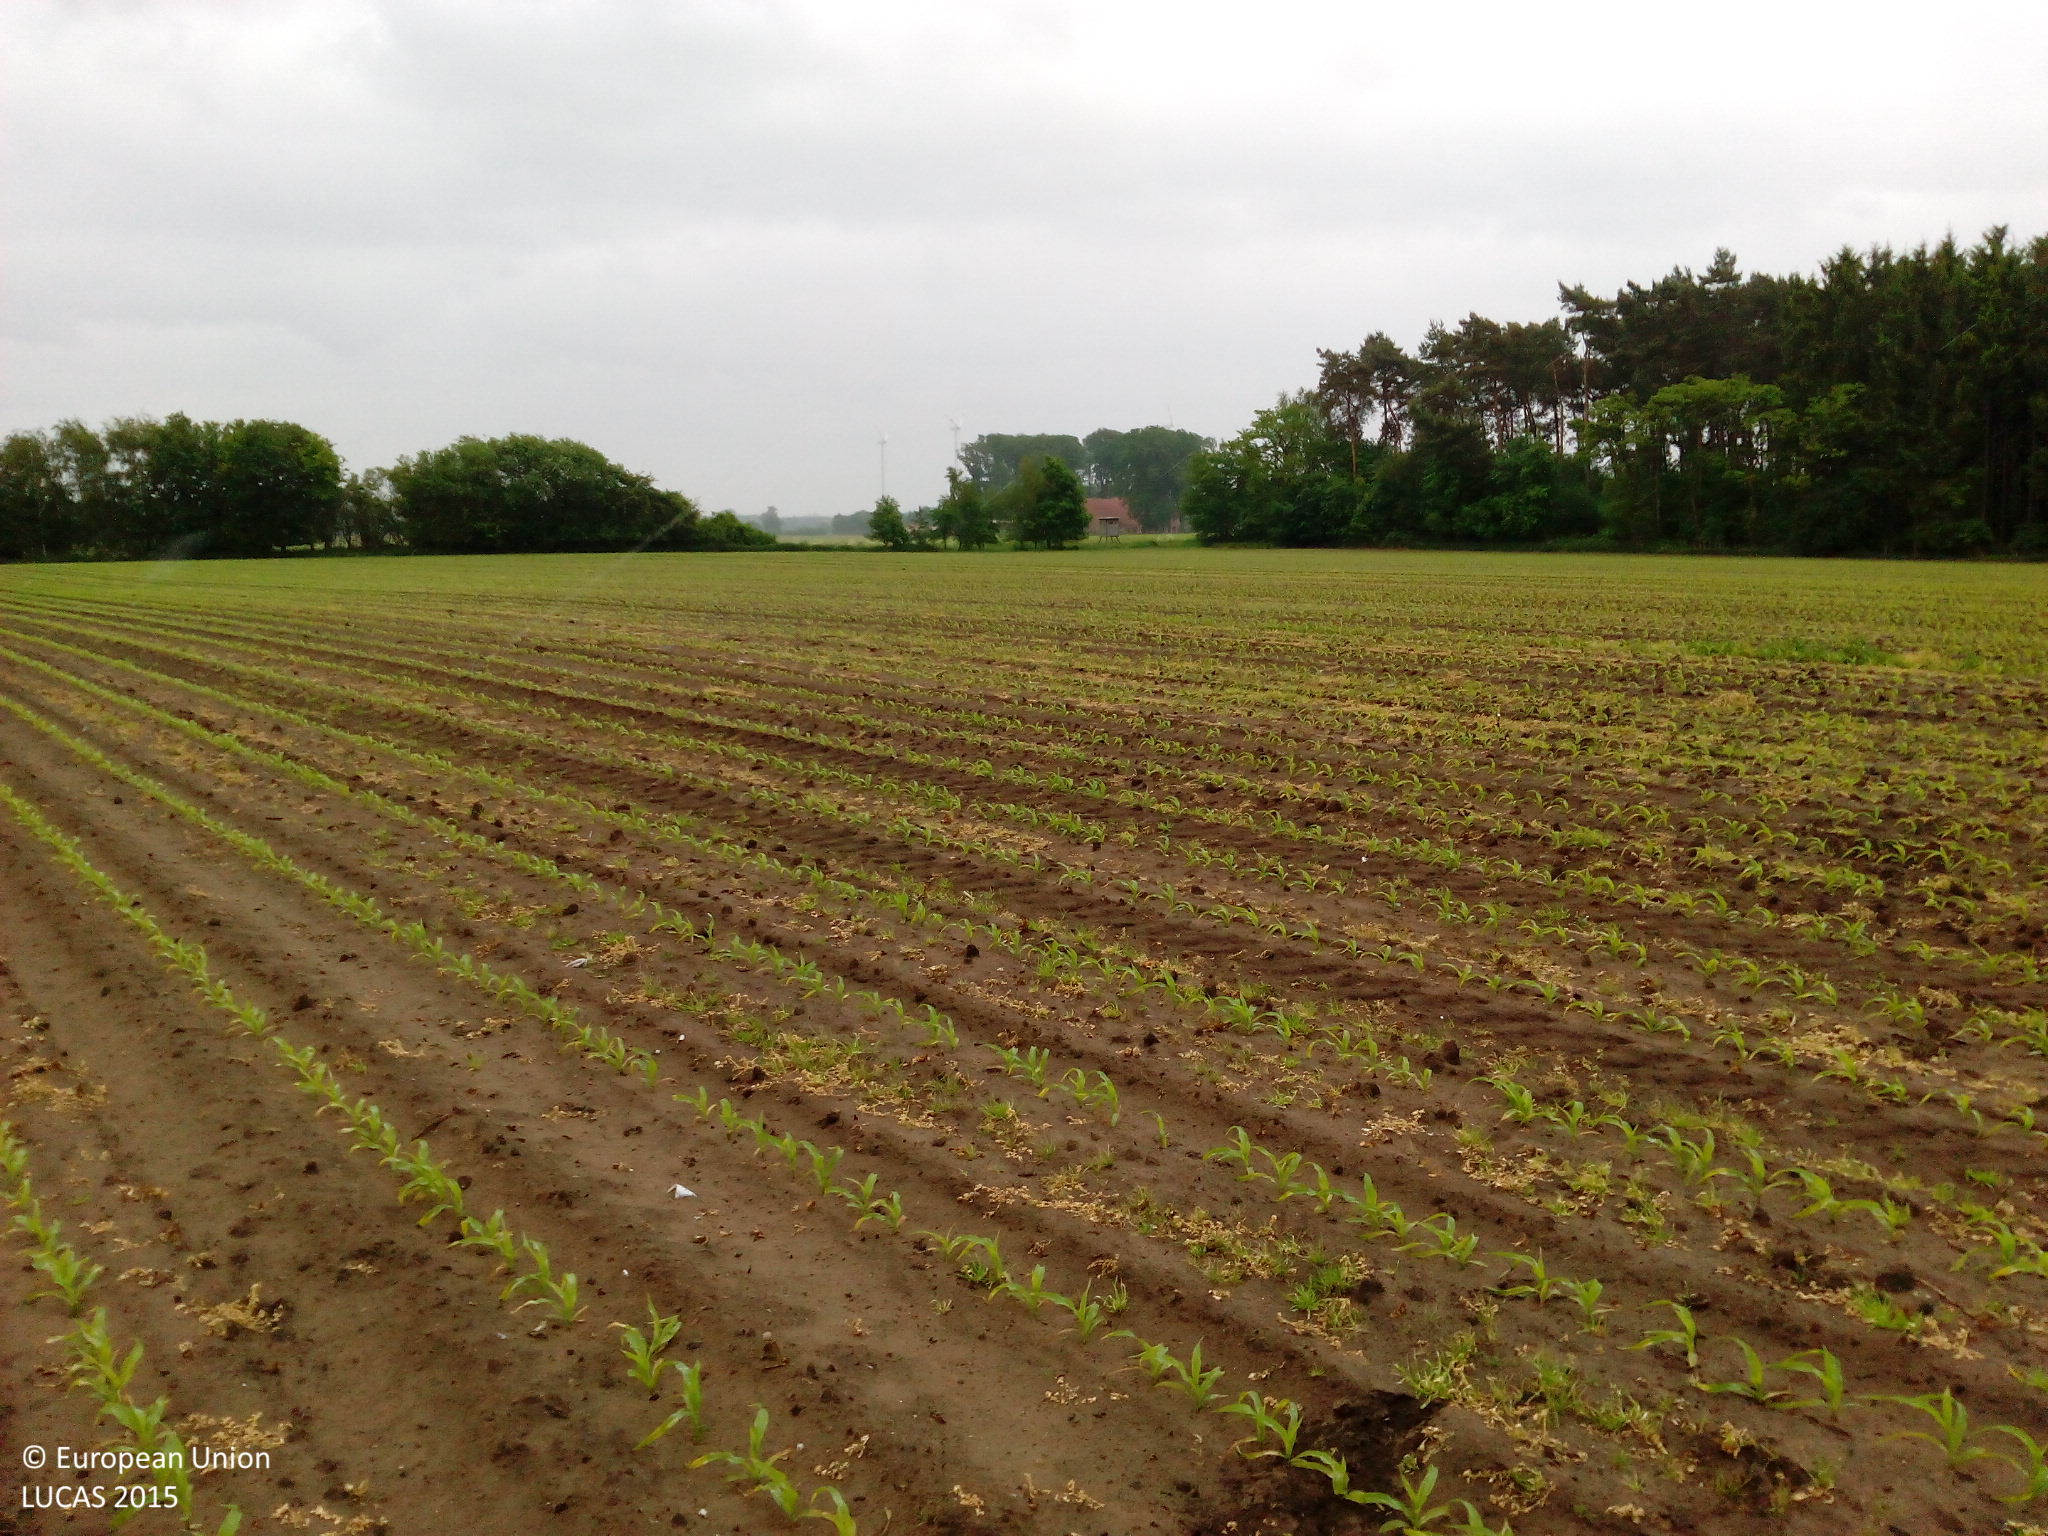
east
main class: Cropland
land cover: Maize
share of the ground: > 75 %
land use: Agriculture (excluding fallow land and kitchen gardens)
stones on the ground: < 10 %
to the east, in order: Maize; Shruby margins; Tracks; Shruby margins; Lines of trees; Maize
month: June
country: DE
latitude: 52.3484
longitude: 7.3726
